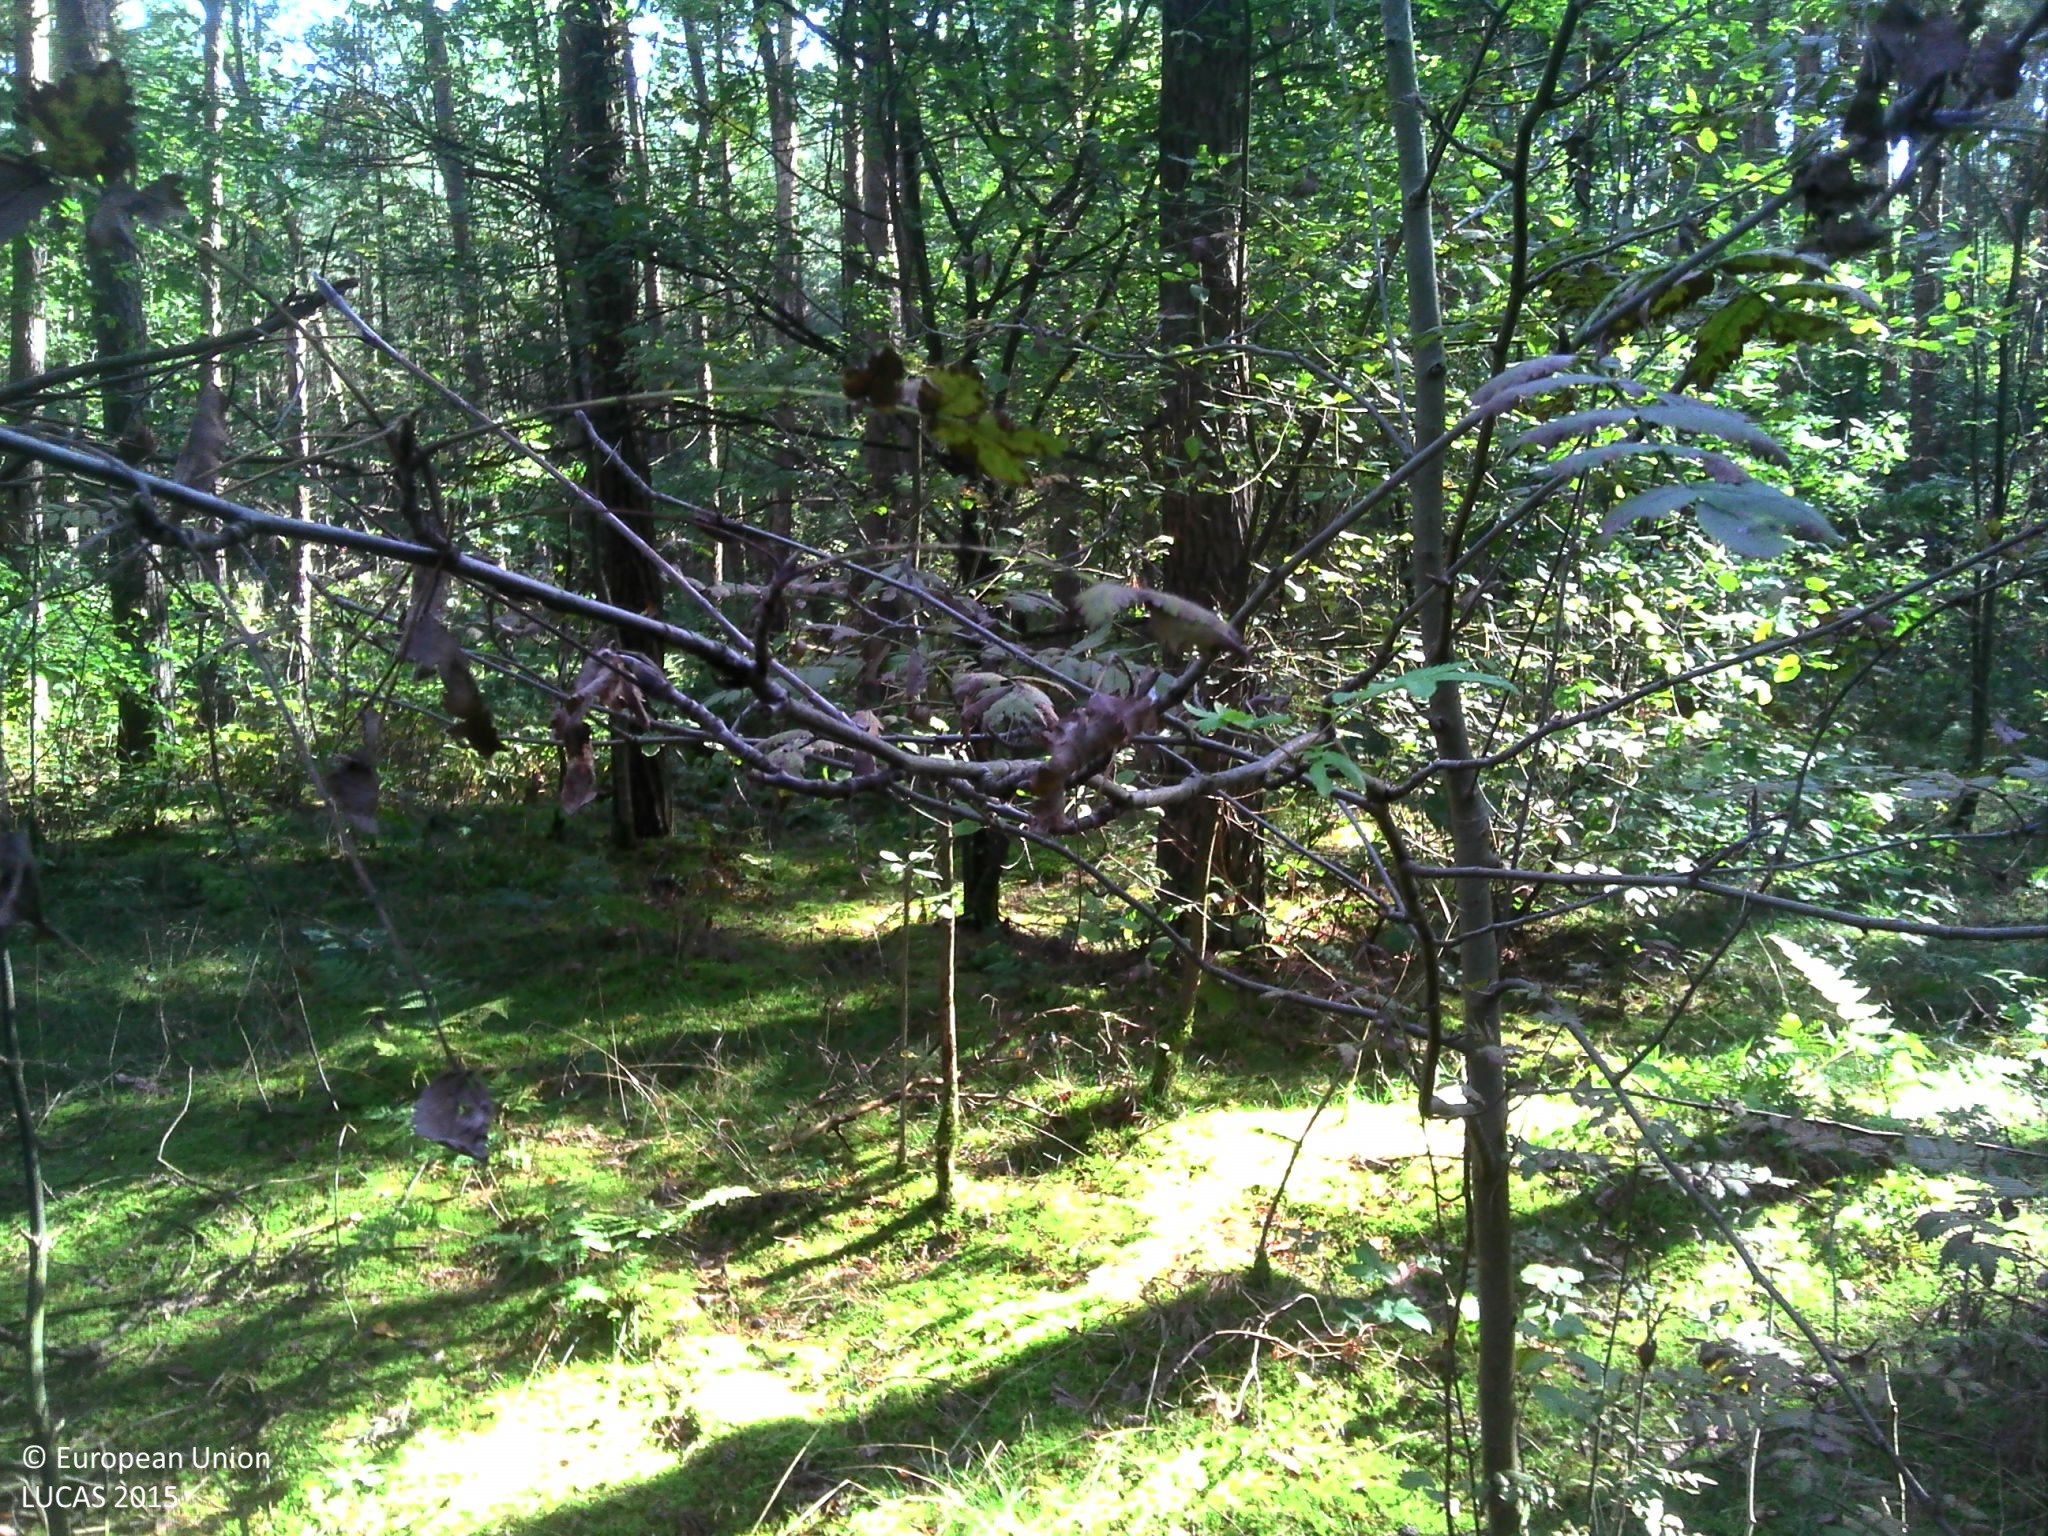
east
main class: Woodland
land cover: Pine dominated coniferous woodland
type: exotic forest
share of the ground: > 75 %
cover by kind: coniferous forest trees 100 %
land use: Forestry
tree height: > 5 m
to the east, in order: Pine dominated coniferous woodland; Tracks; Pine dominated coniferous woodland; Ditches and canals; Grass margins; Paved roads, cycling and walking lanes; Grass margins; Ditches and canals; Grass margins; Pine dominated coniferous woodland
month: September
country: BE
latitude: 51.2354
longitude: 4.7688
